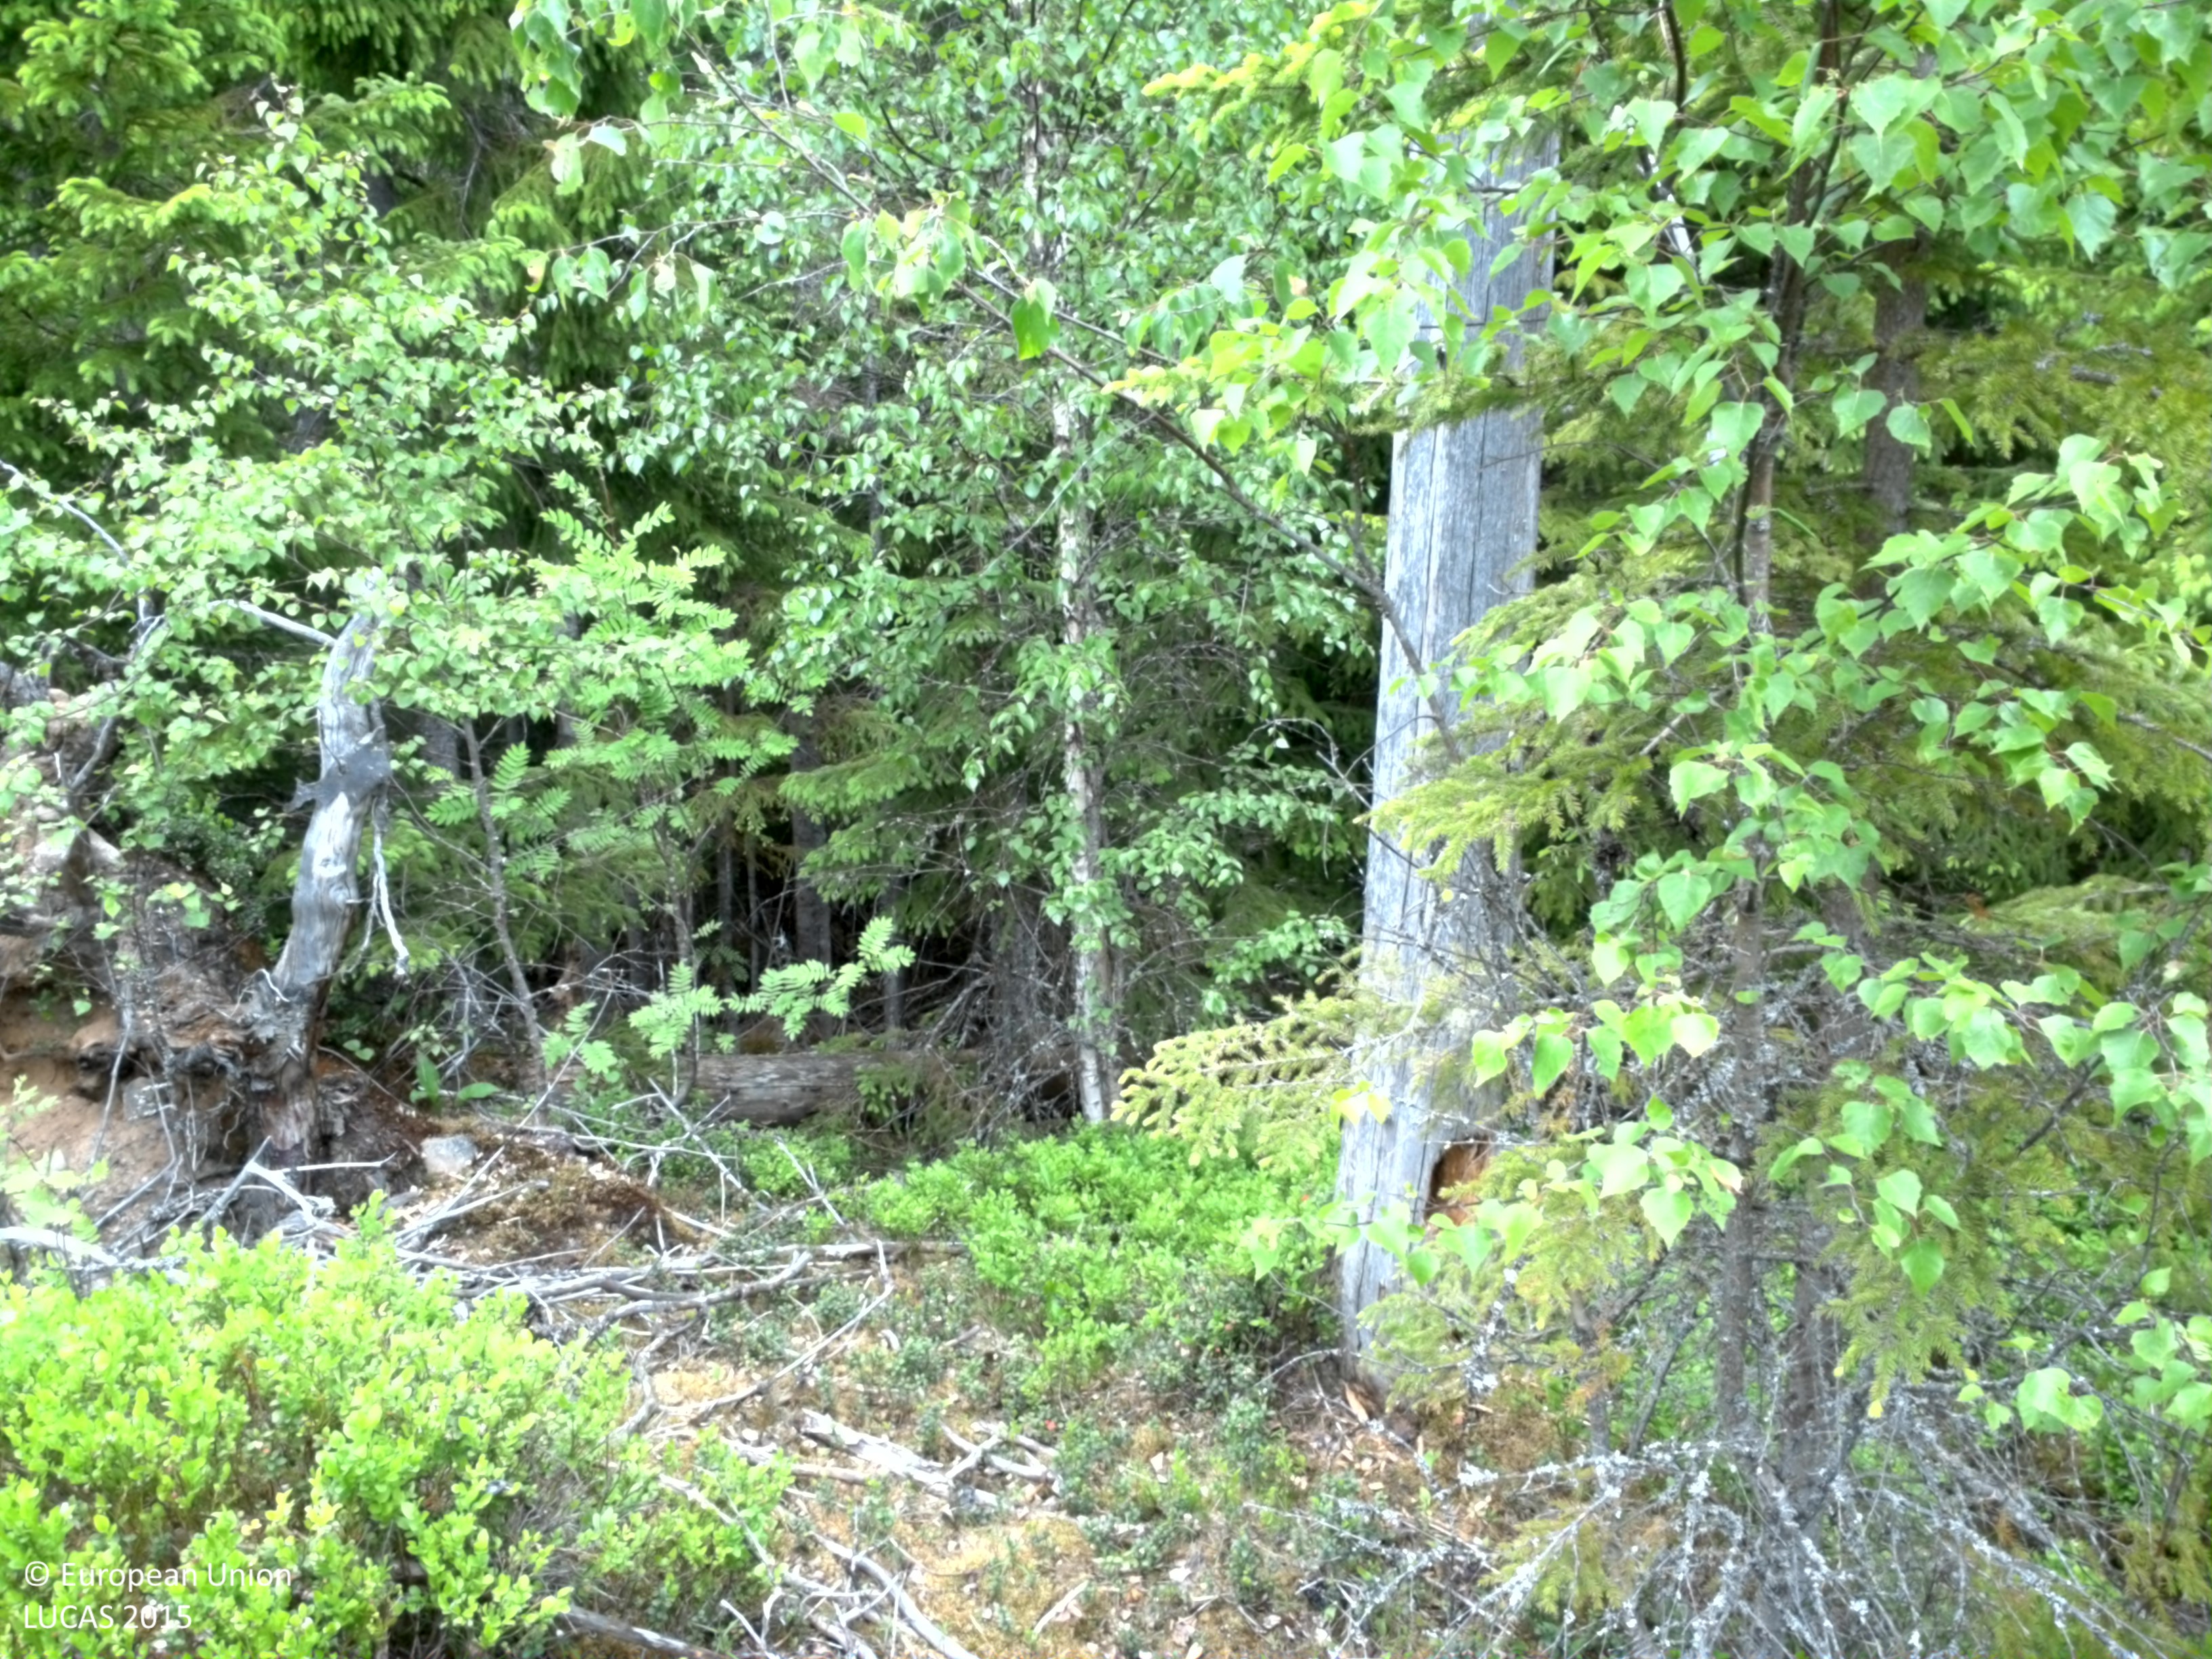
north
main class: Woodland
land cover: Spruce dominated mixed woodland
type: boreal forest
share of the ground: 50 - 75 %
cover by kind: coniferous forest trees 40 %, broadleaved forest trees 30 %, shrubs 15 %, herbaceous plants 10 %, lichens and mosses 5 %
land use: Forestry
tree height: < 5 m
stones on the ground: < 10 %
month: June
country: SE
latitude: 59.5892
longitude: 14.4008
